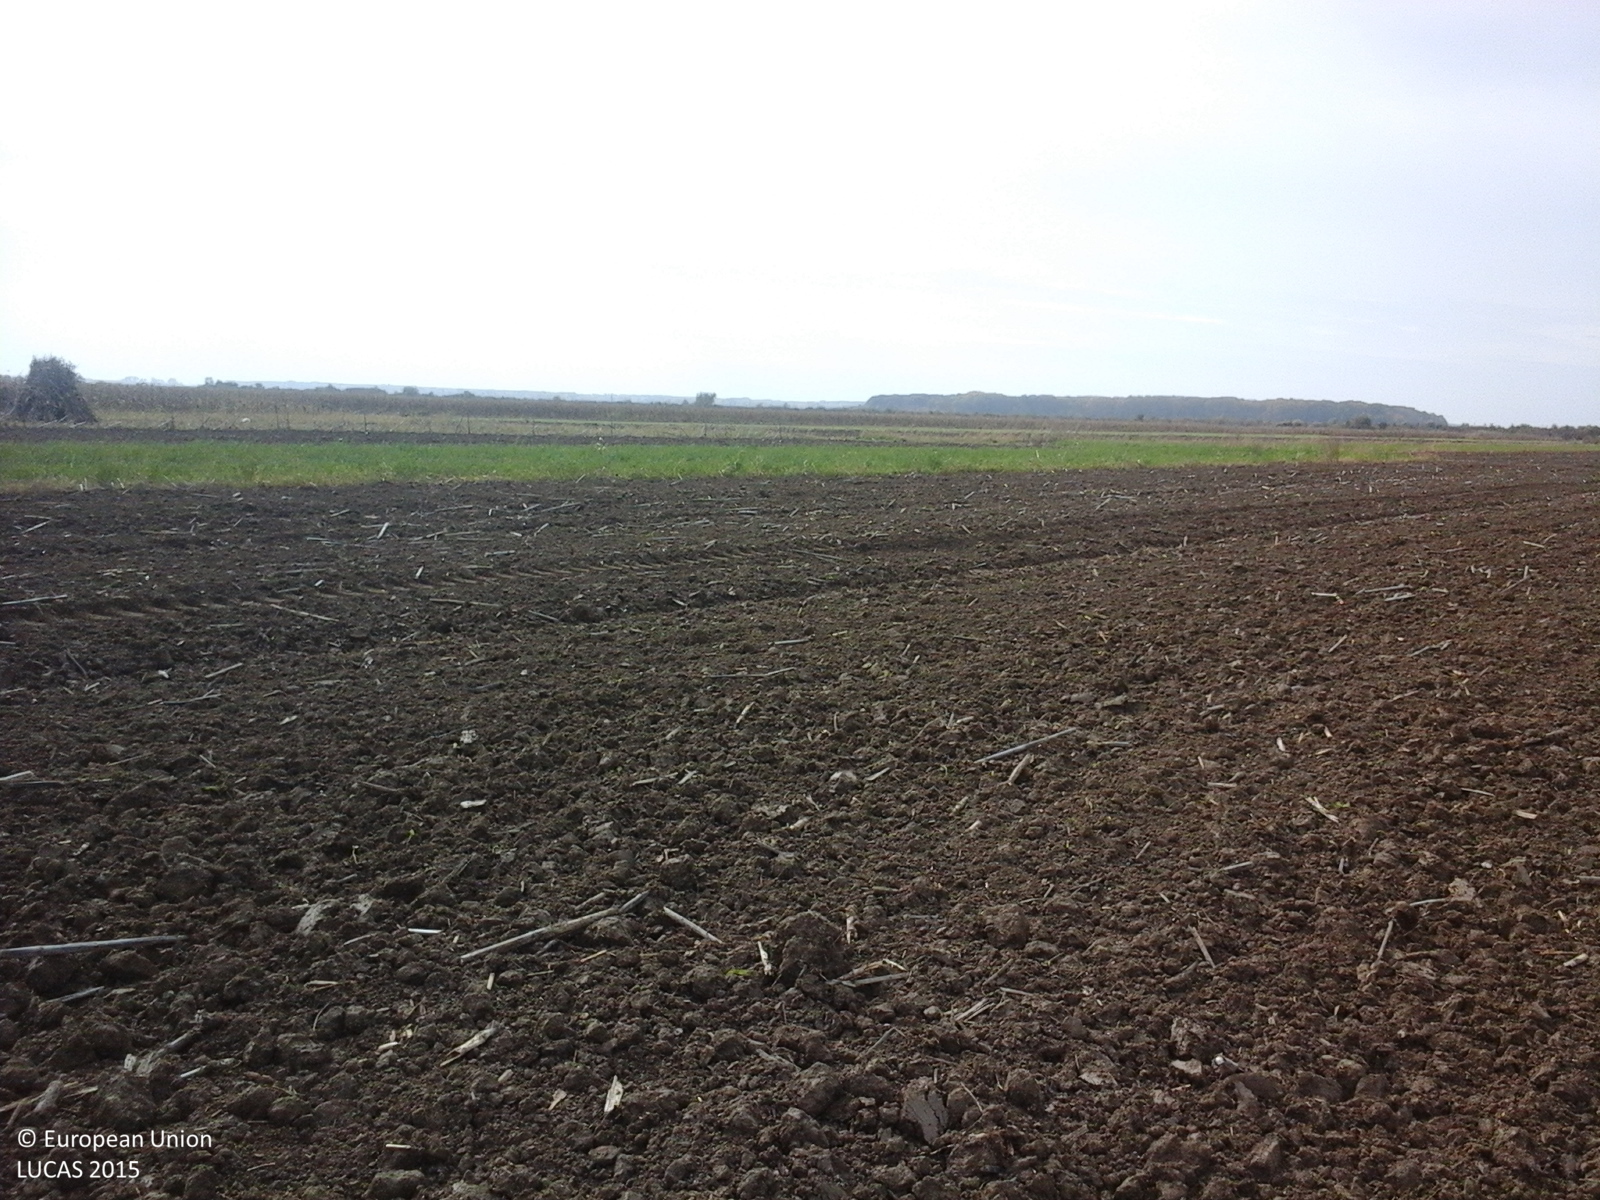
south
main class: Cropland
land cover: Maize
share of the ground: < 10 %
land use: Agriculture (excluding fallow land and kitchen gardens)
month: October
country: RO
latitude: 44.8362
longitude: 26.1633
